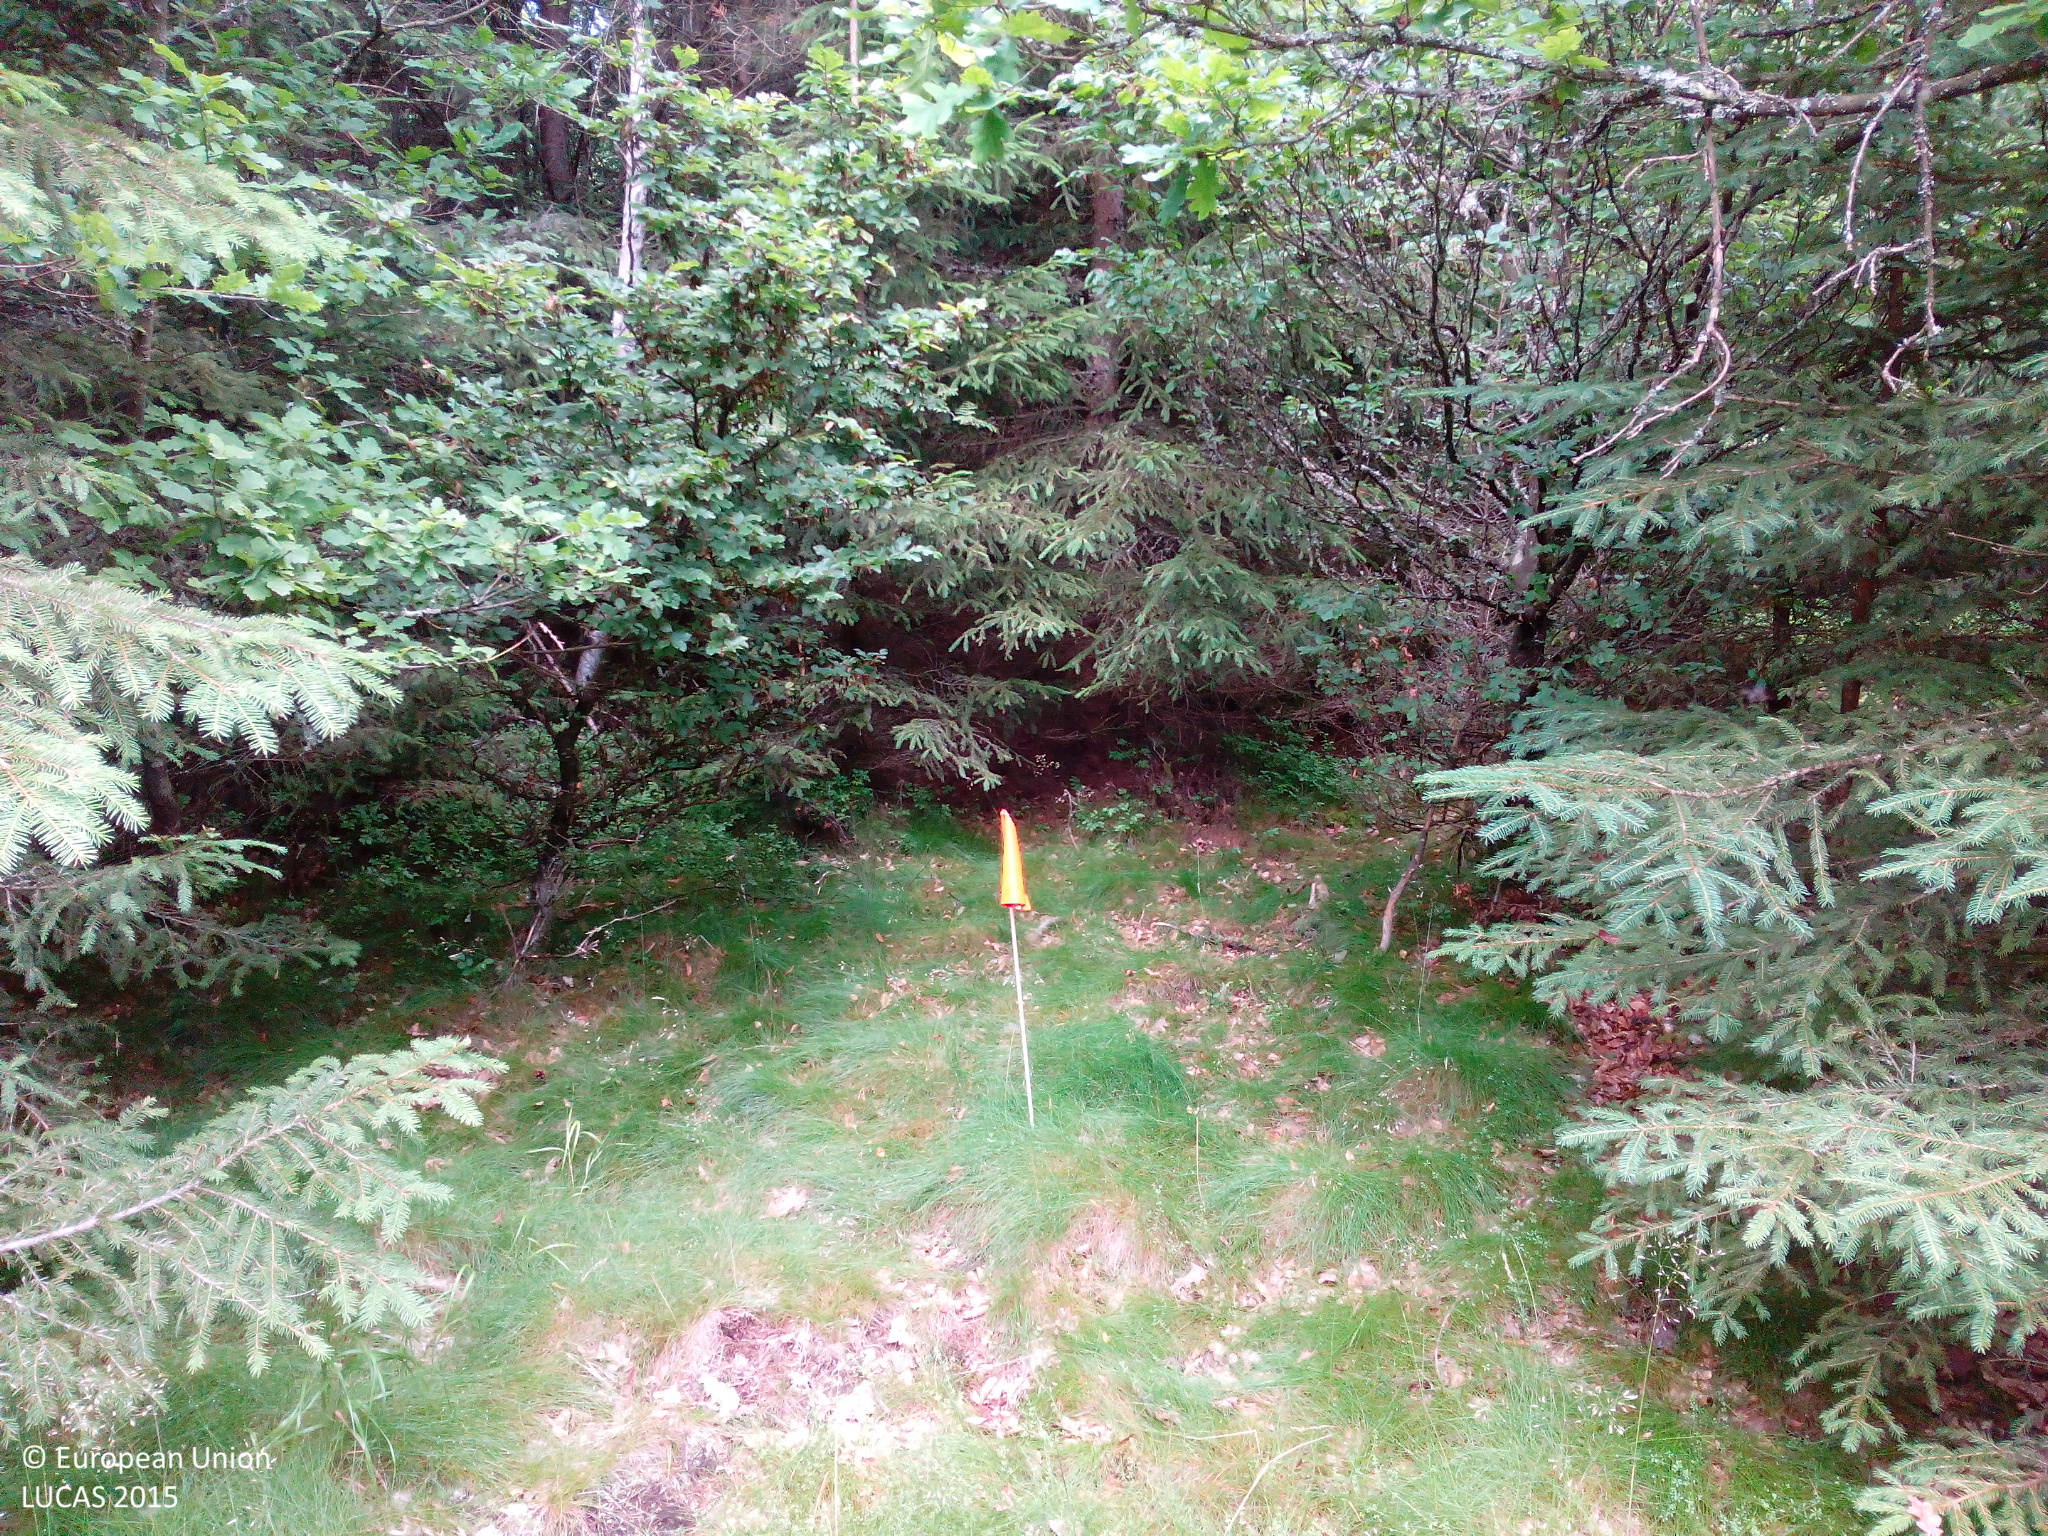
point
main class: Woodland
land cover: Spruce dominated mixed woodland
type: hemiboreal forest and nemoral coniferous forest and mixed broadleaved-coniferous forest
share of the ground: > 75 %
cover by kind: coniferous forest trees 60 %, broadleaved forest trees 25 %, herbaceous plants 15 %
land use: Forestry
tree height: < 5 m
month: July
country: DE
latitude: 49.7098
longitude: 12.3709
